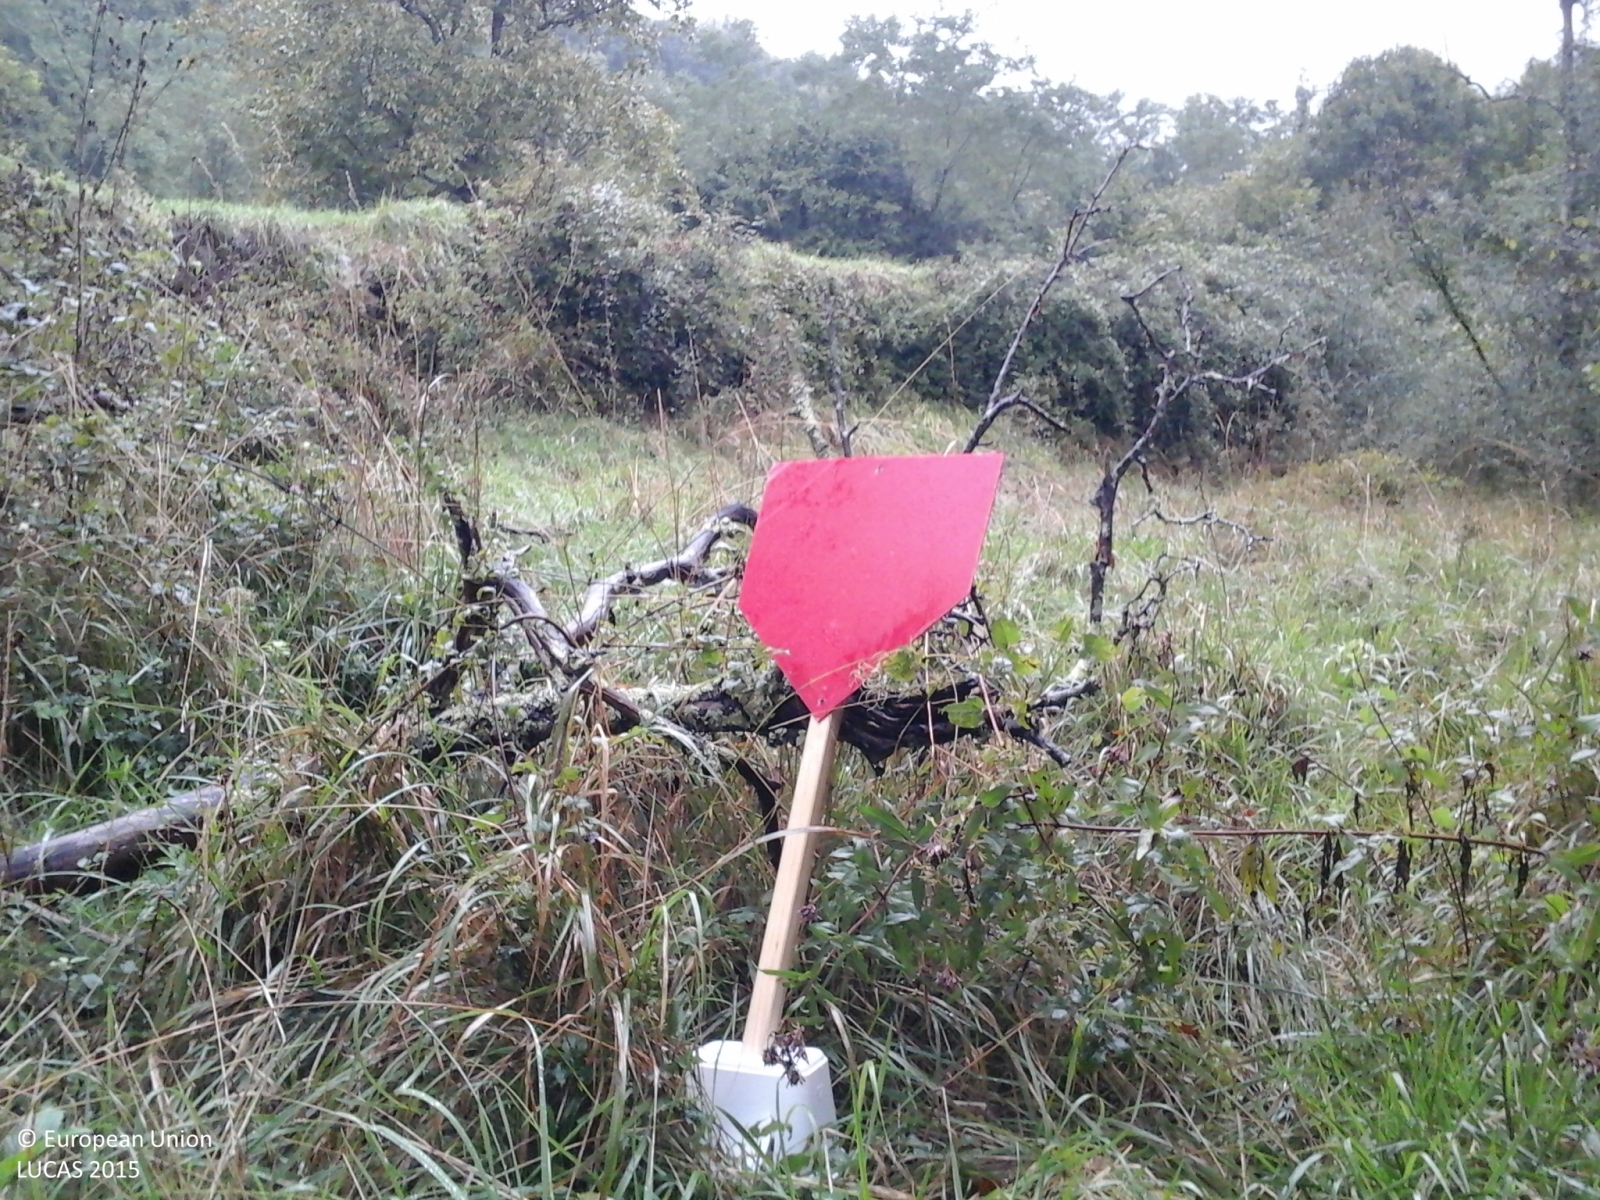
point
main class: Woodland
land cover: Broadleaved woodland
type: thermophilous deciduous forest
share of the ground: > 75 %
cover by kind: broadleaved forest trees 60 %, herbaceous plants 30 %, shrubs 10 %
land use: Semi-natural and natural areas not in use
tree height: > 5 m
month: September
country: IT
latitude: 44.4568
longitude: 9.3605
